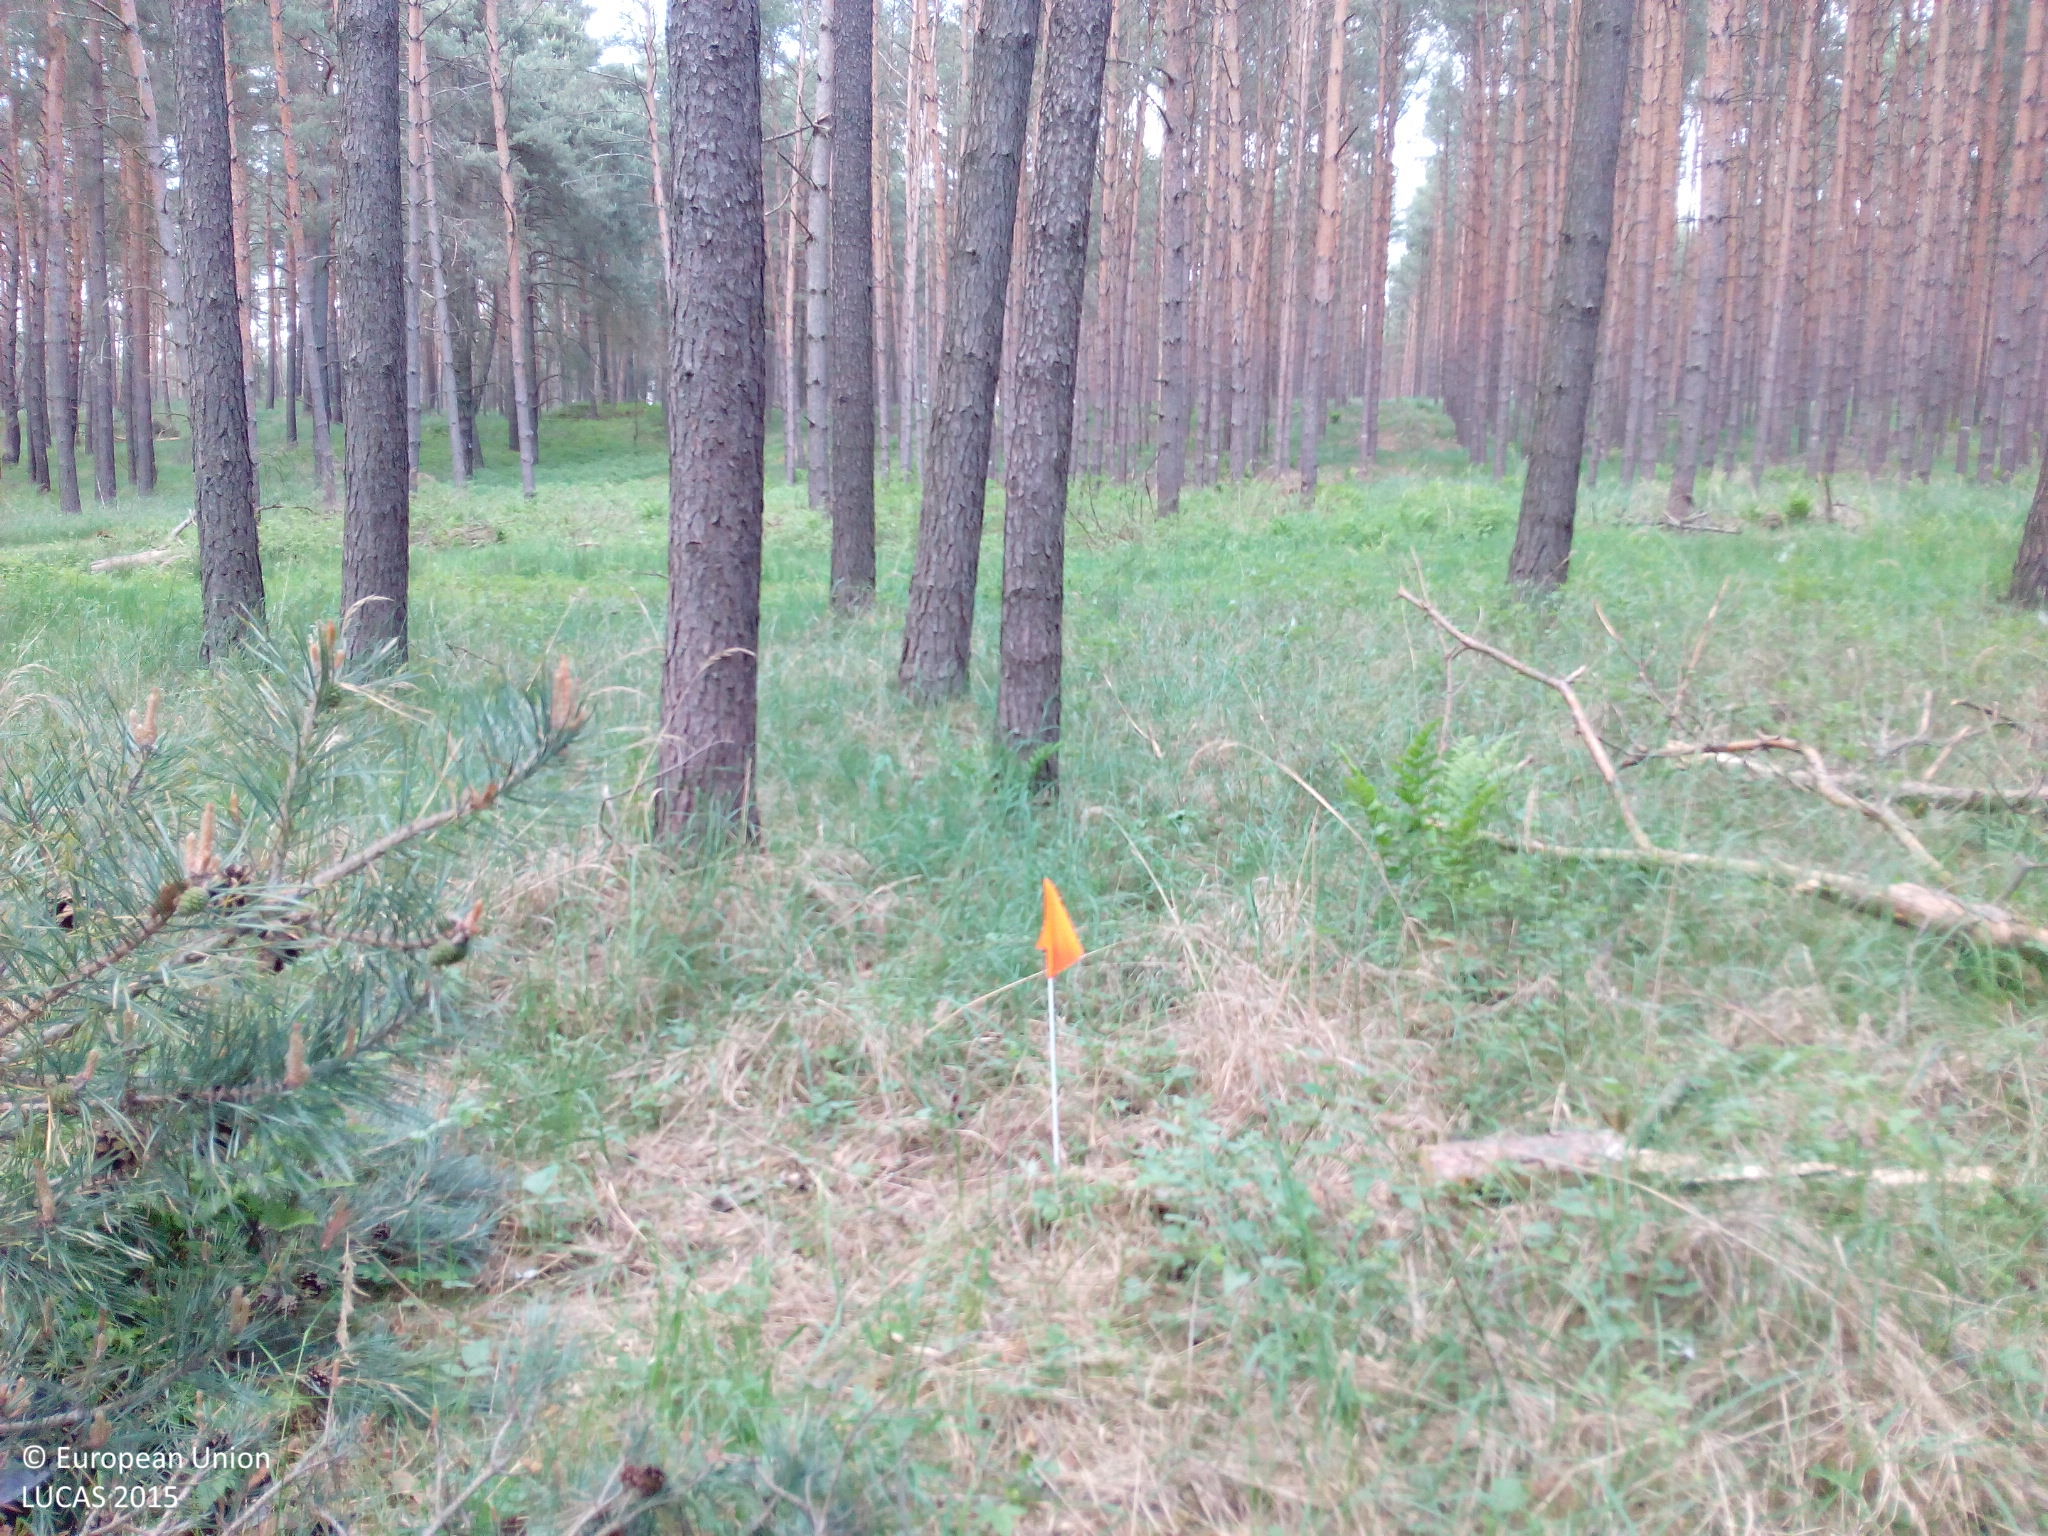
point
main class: Woodland
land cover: Pine dominated coniferous woodland
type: hemiboreal forest and nemoral coniferous forest and mixed broadleaved-coniferous forest
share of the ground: > 75 %
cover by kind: coniferous forest trees 90 %, shrubs 5 %, herbaceous plants 5 %
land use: Forestry
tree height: > 5 m
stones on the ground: < 10 %
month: May
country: DE
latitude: 52.0623
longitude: 12.5523
